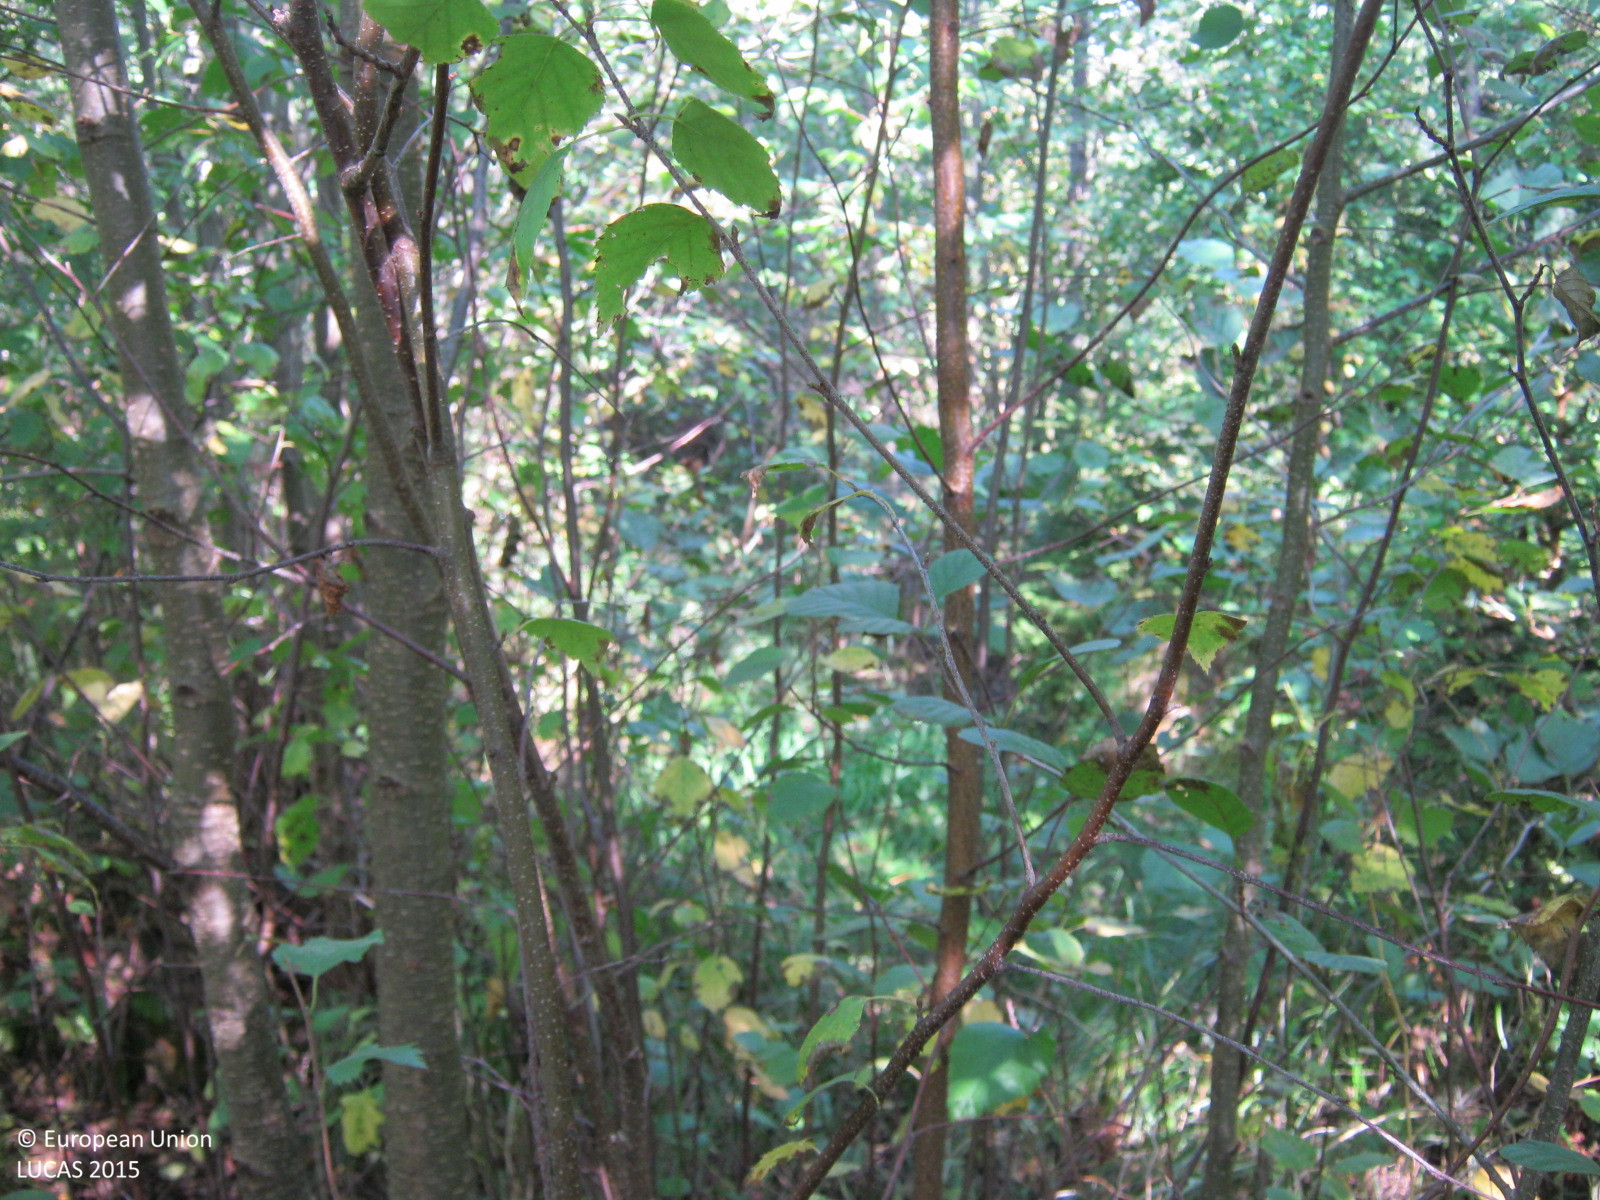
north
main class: Woodland
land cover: Broadleaved woodland
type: non-riverine alder, birch or aspen forest
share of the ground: > 75 %
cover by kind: broadleaved forest trees 90 %, herbaceous plants 10 %
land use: Forestry
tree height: > 5 m
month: September
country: LV
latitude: 57.4062
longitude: 24.5229
